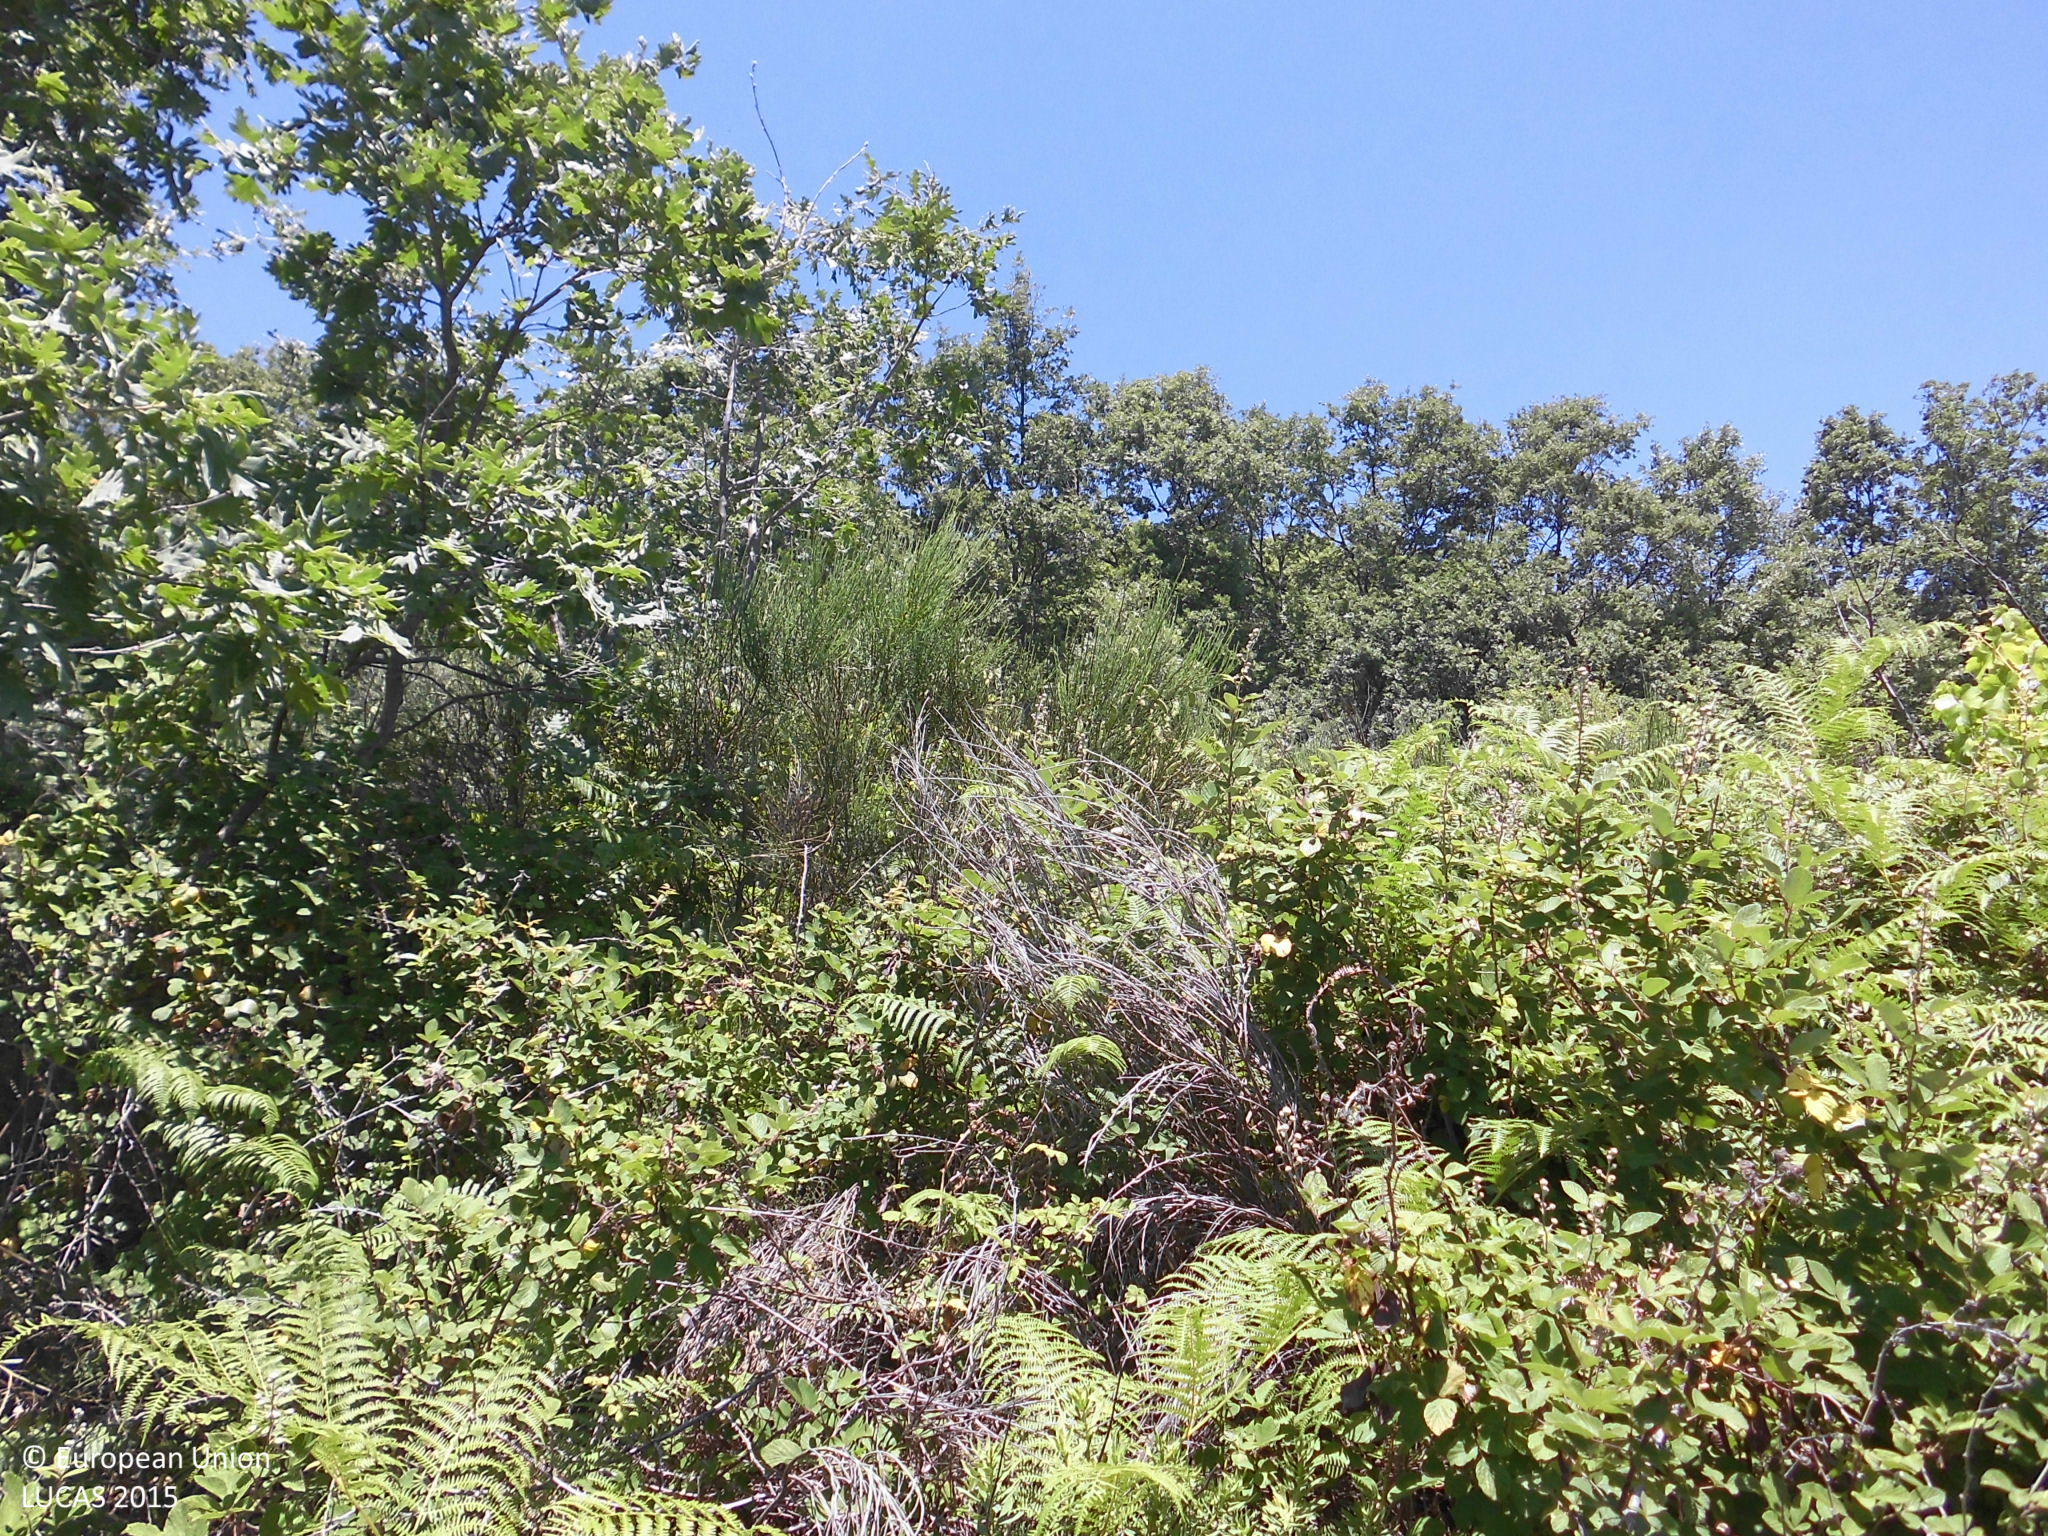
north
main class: Woodland
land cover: Broadleaved woodland
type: thermophilous deciduous forest
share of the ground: 10 - 25 %
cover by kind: shrubs 90 %, broadleaved forest trees 10 %
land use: Forestry
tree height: > 5 m
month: June
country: ES
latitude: 40.1309
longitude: -5.4942
